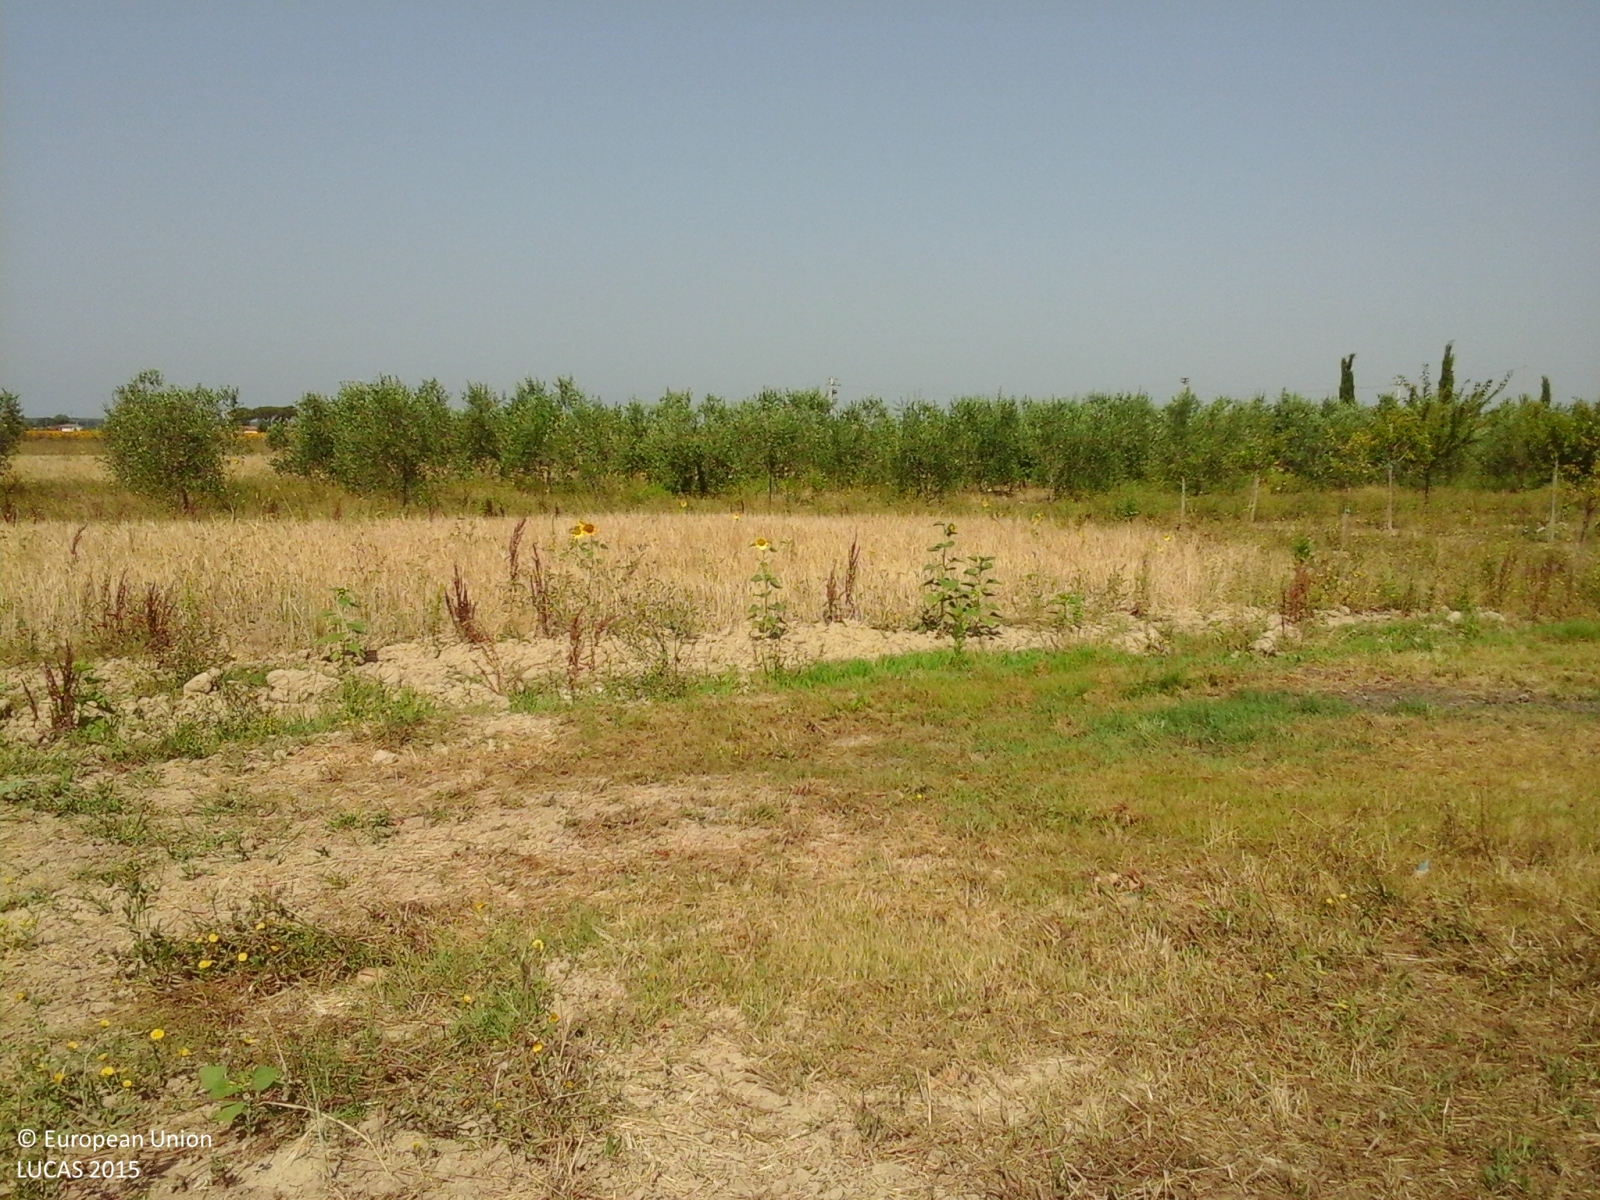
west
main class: Cropland
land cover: Barley
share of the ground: > 75 %
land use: Agriculture (excluding fallow land and kitchen gardens)
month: July
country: IT
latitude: 42.7210
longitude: 11.0346
